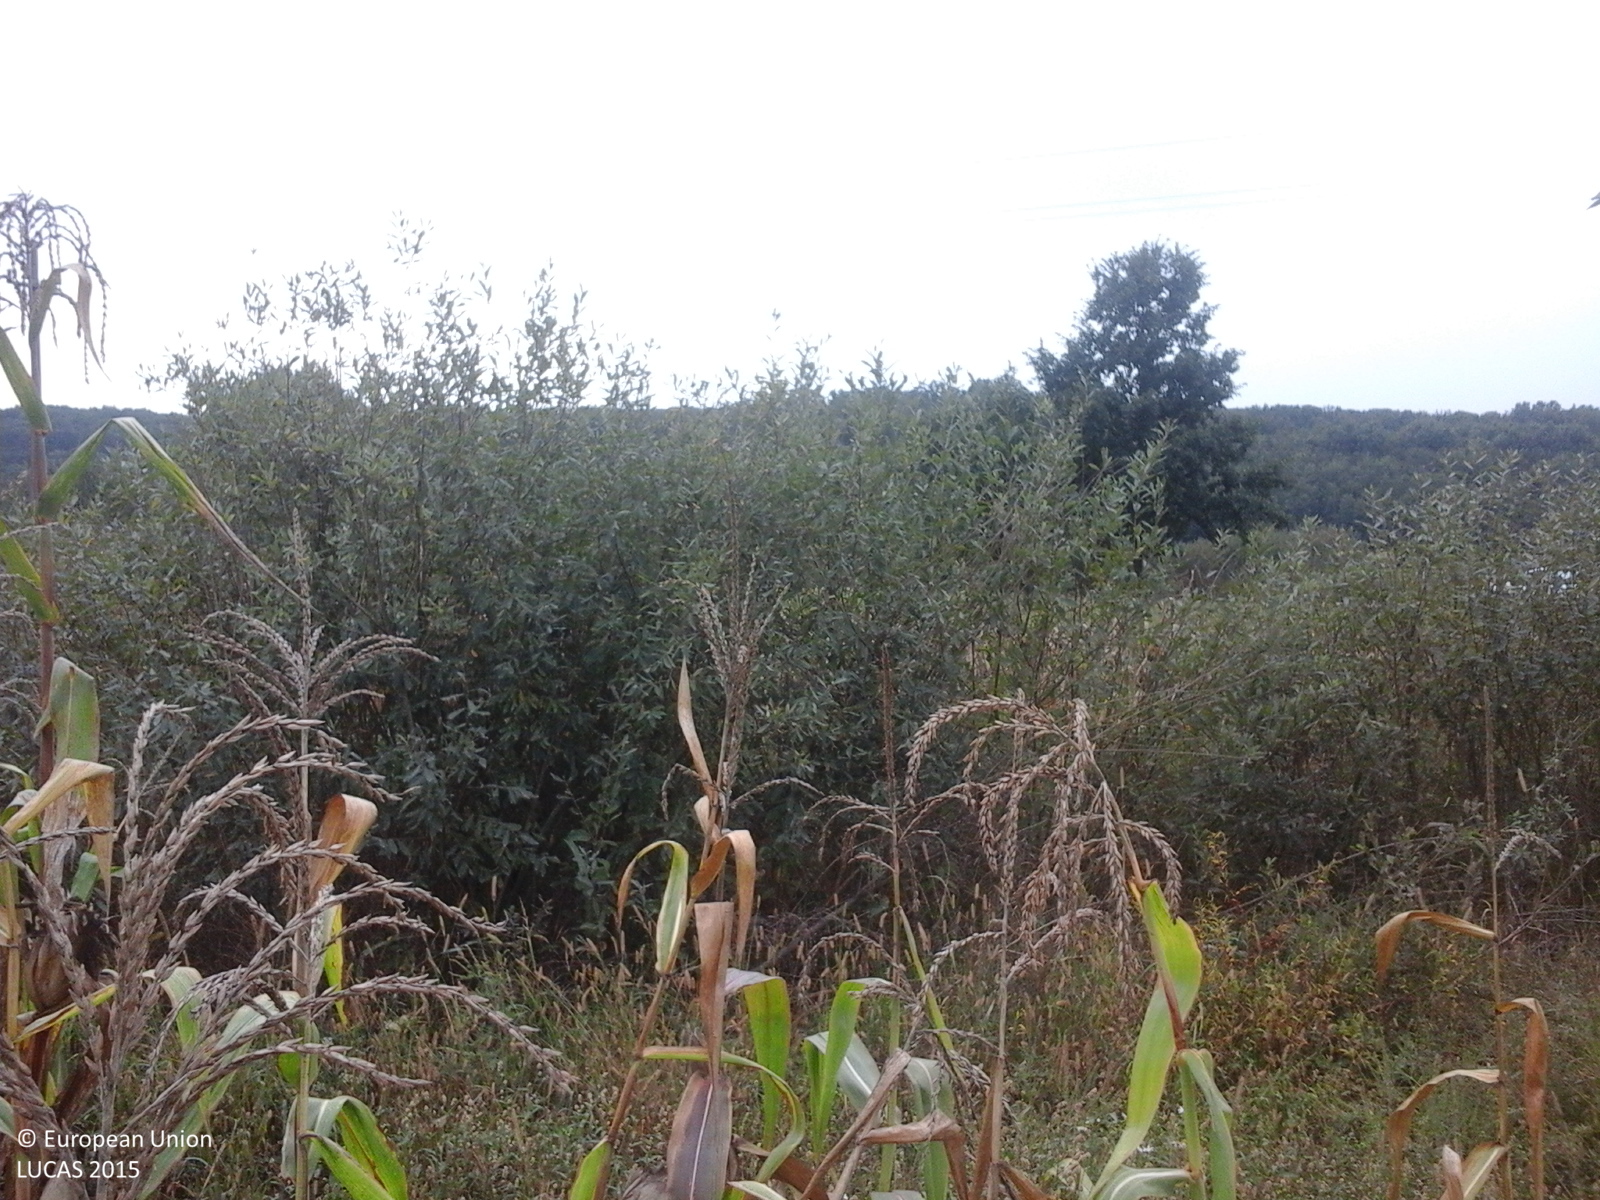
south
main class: Cropland
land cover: Maize
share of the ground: > 75 %
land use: Agriculture (excluding fallow land and kitchen gardens)
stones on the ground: < 10 %
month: September
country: RO
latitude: 45.8280
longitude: 22.2340
